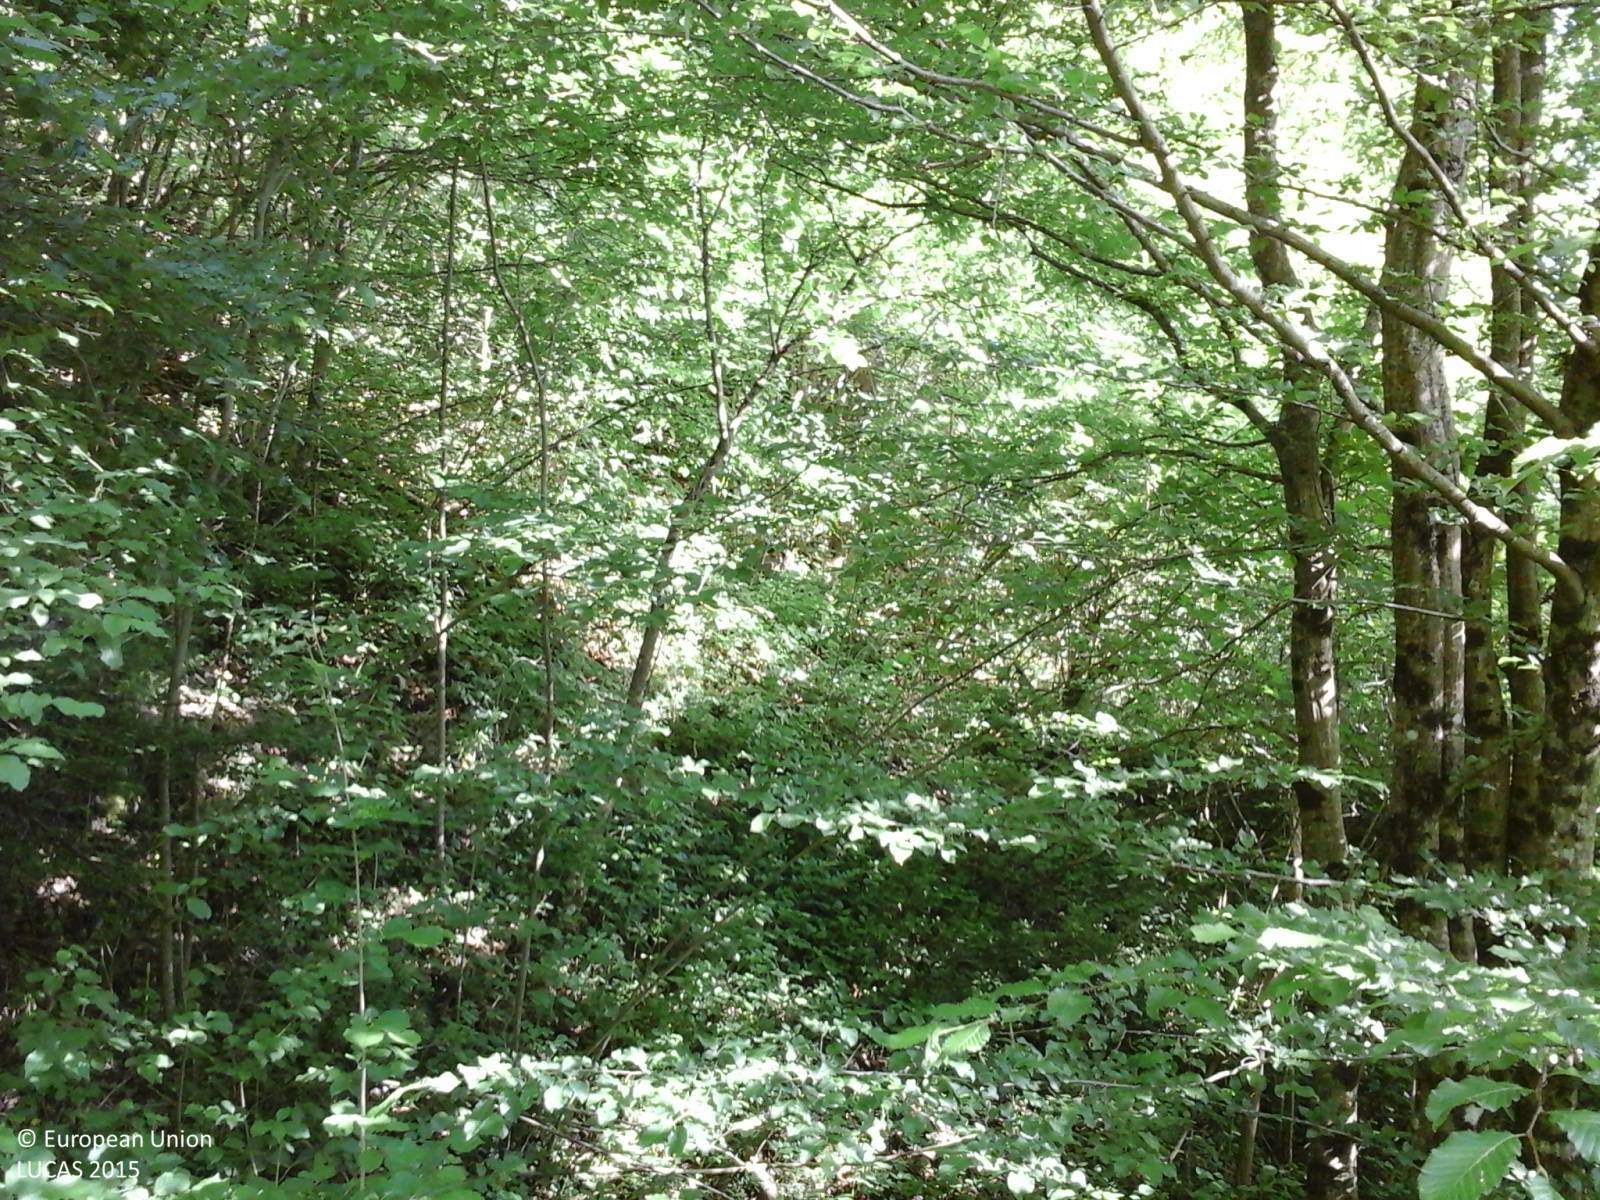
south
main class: Shrubland
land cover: Shrubland with sparse tree cover
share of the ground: > 75 %
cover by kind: shrubs 90 %, broadleaved forest trees 5 %, herbaceous plants 5 %
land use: Semi-natural and natural areas not in use
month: May
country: IT
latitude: 42.1352
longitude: 13.1469
